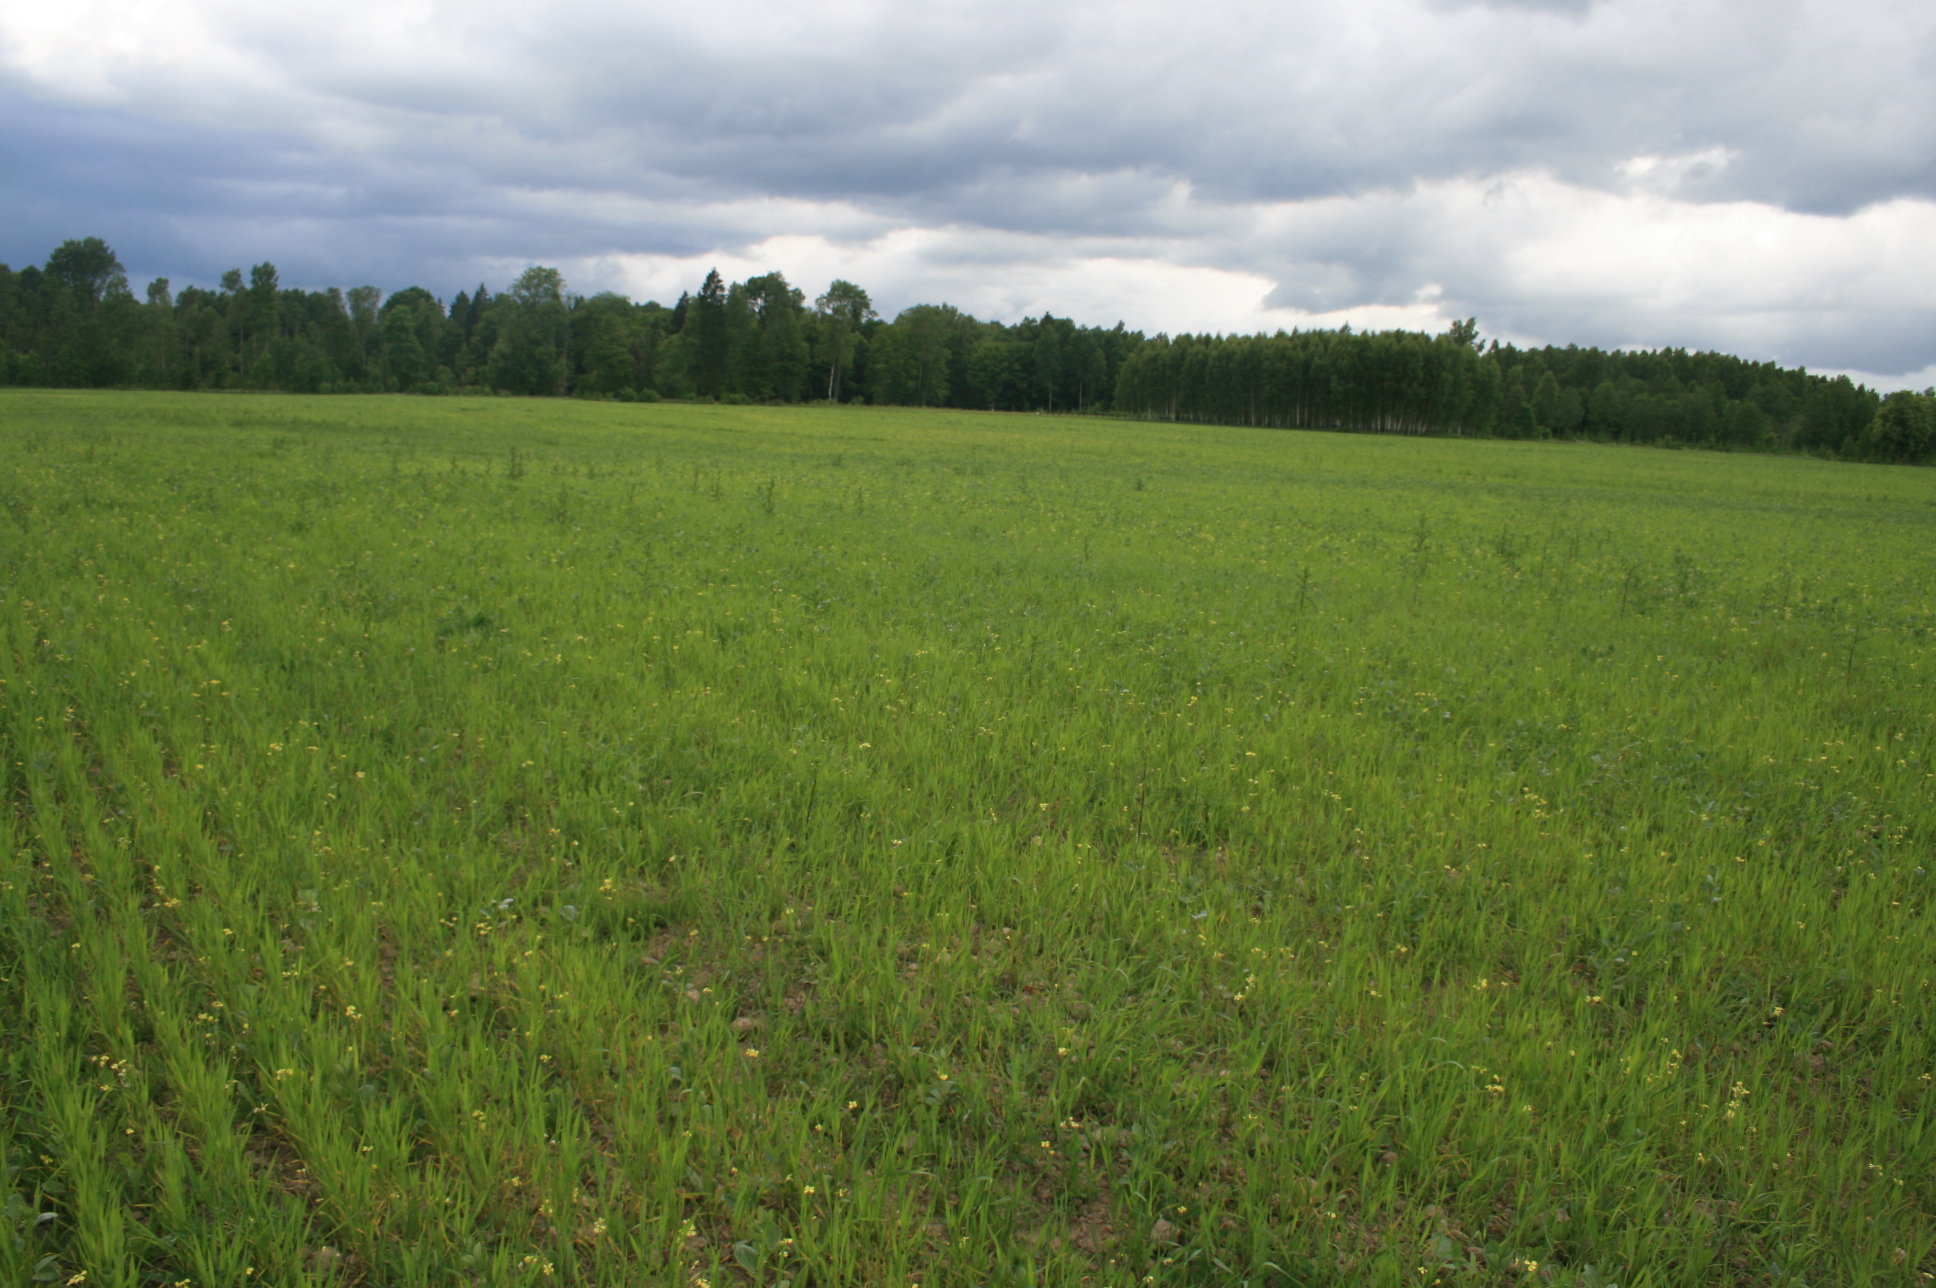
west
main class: Cropland
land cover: Other leguminous and mixtures for fodder
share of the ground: > 75 %
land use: Agriculture (excluding fallow land and kitchen gardens)
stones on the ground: < 10 %
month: June
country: LT
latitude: 55.3905
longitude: 22.3249
